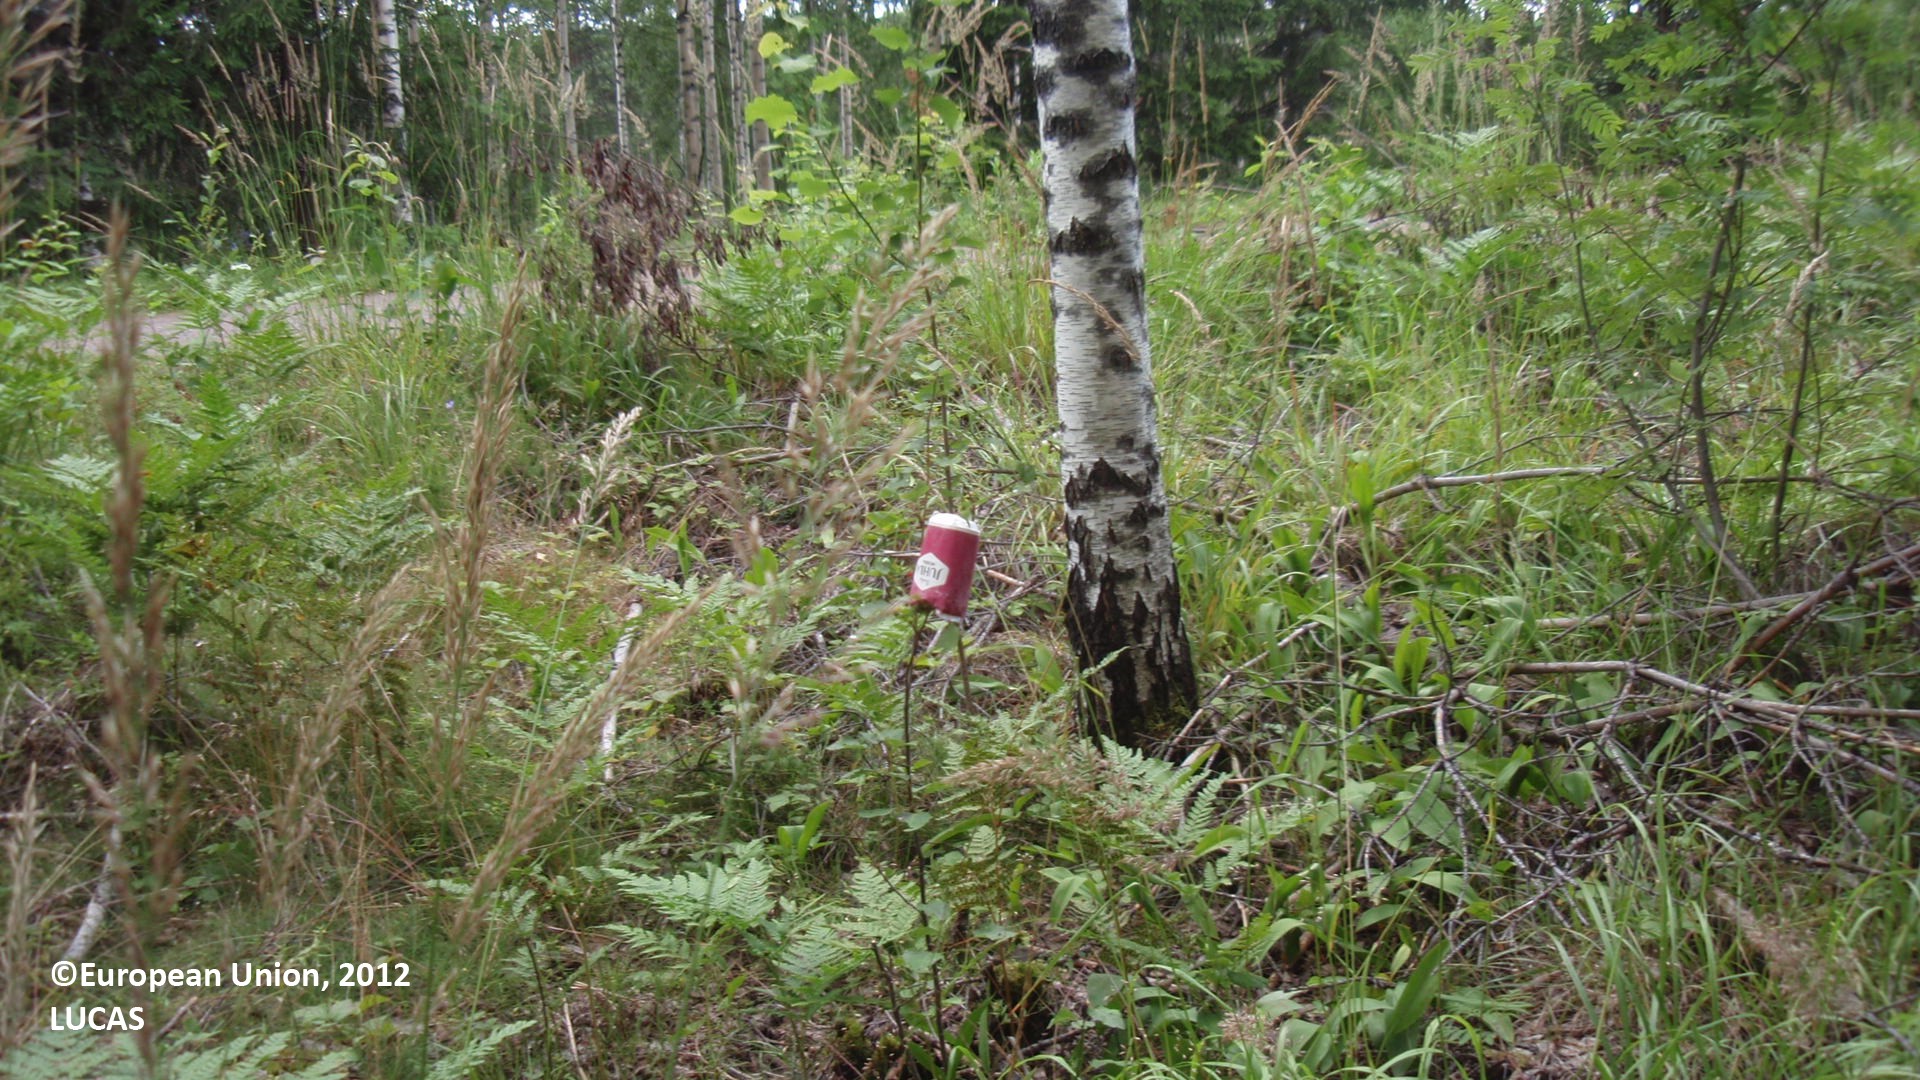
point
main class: Woodland
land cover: Spruce dominated mixed woodland
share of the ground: 50 - 75 %
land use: Forestry
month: July
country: FI
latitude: 61.3796
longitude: 28.8858
